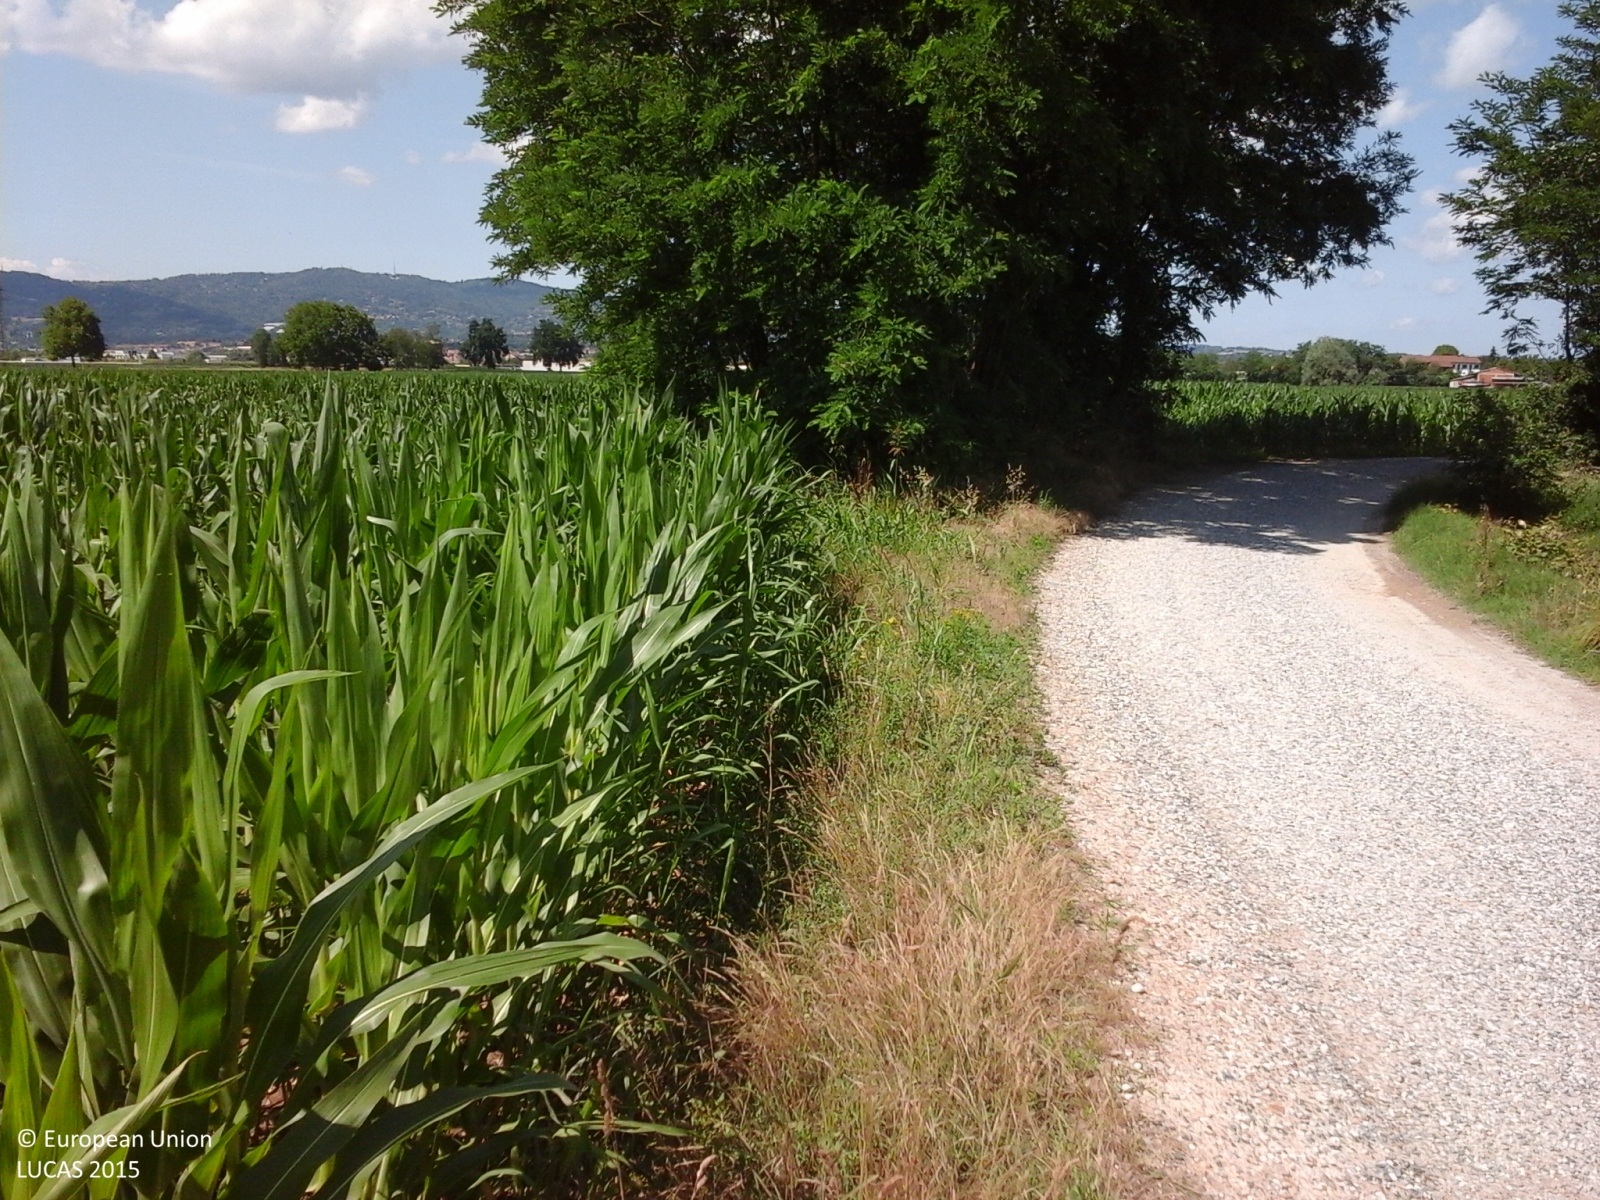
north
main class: Cropland
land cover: Maize
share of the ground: > 75 %
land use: Agriculture (excluding fallow land and kitchen gardens)
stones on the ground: 10 - 25 %
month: June
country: IT
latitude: 44.9572
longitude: 7.7350
